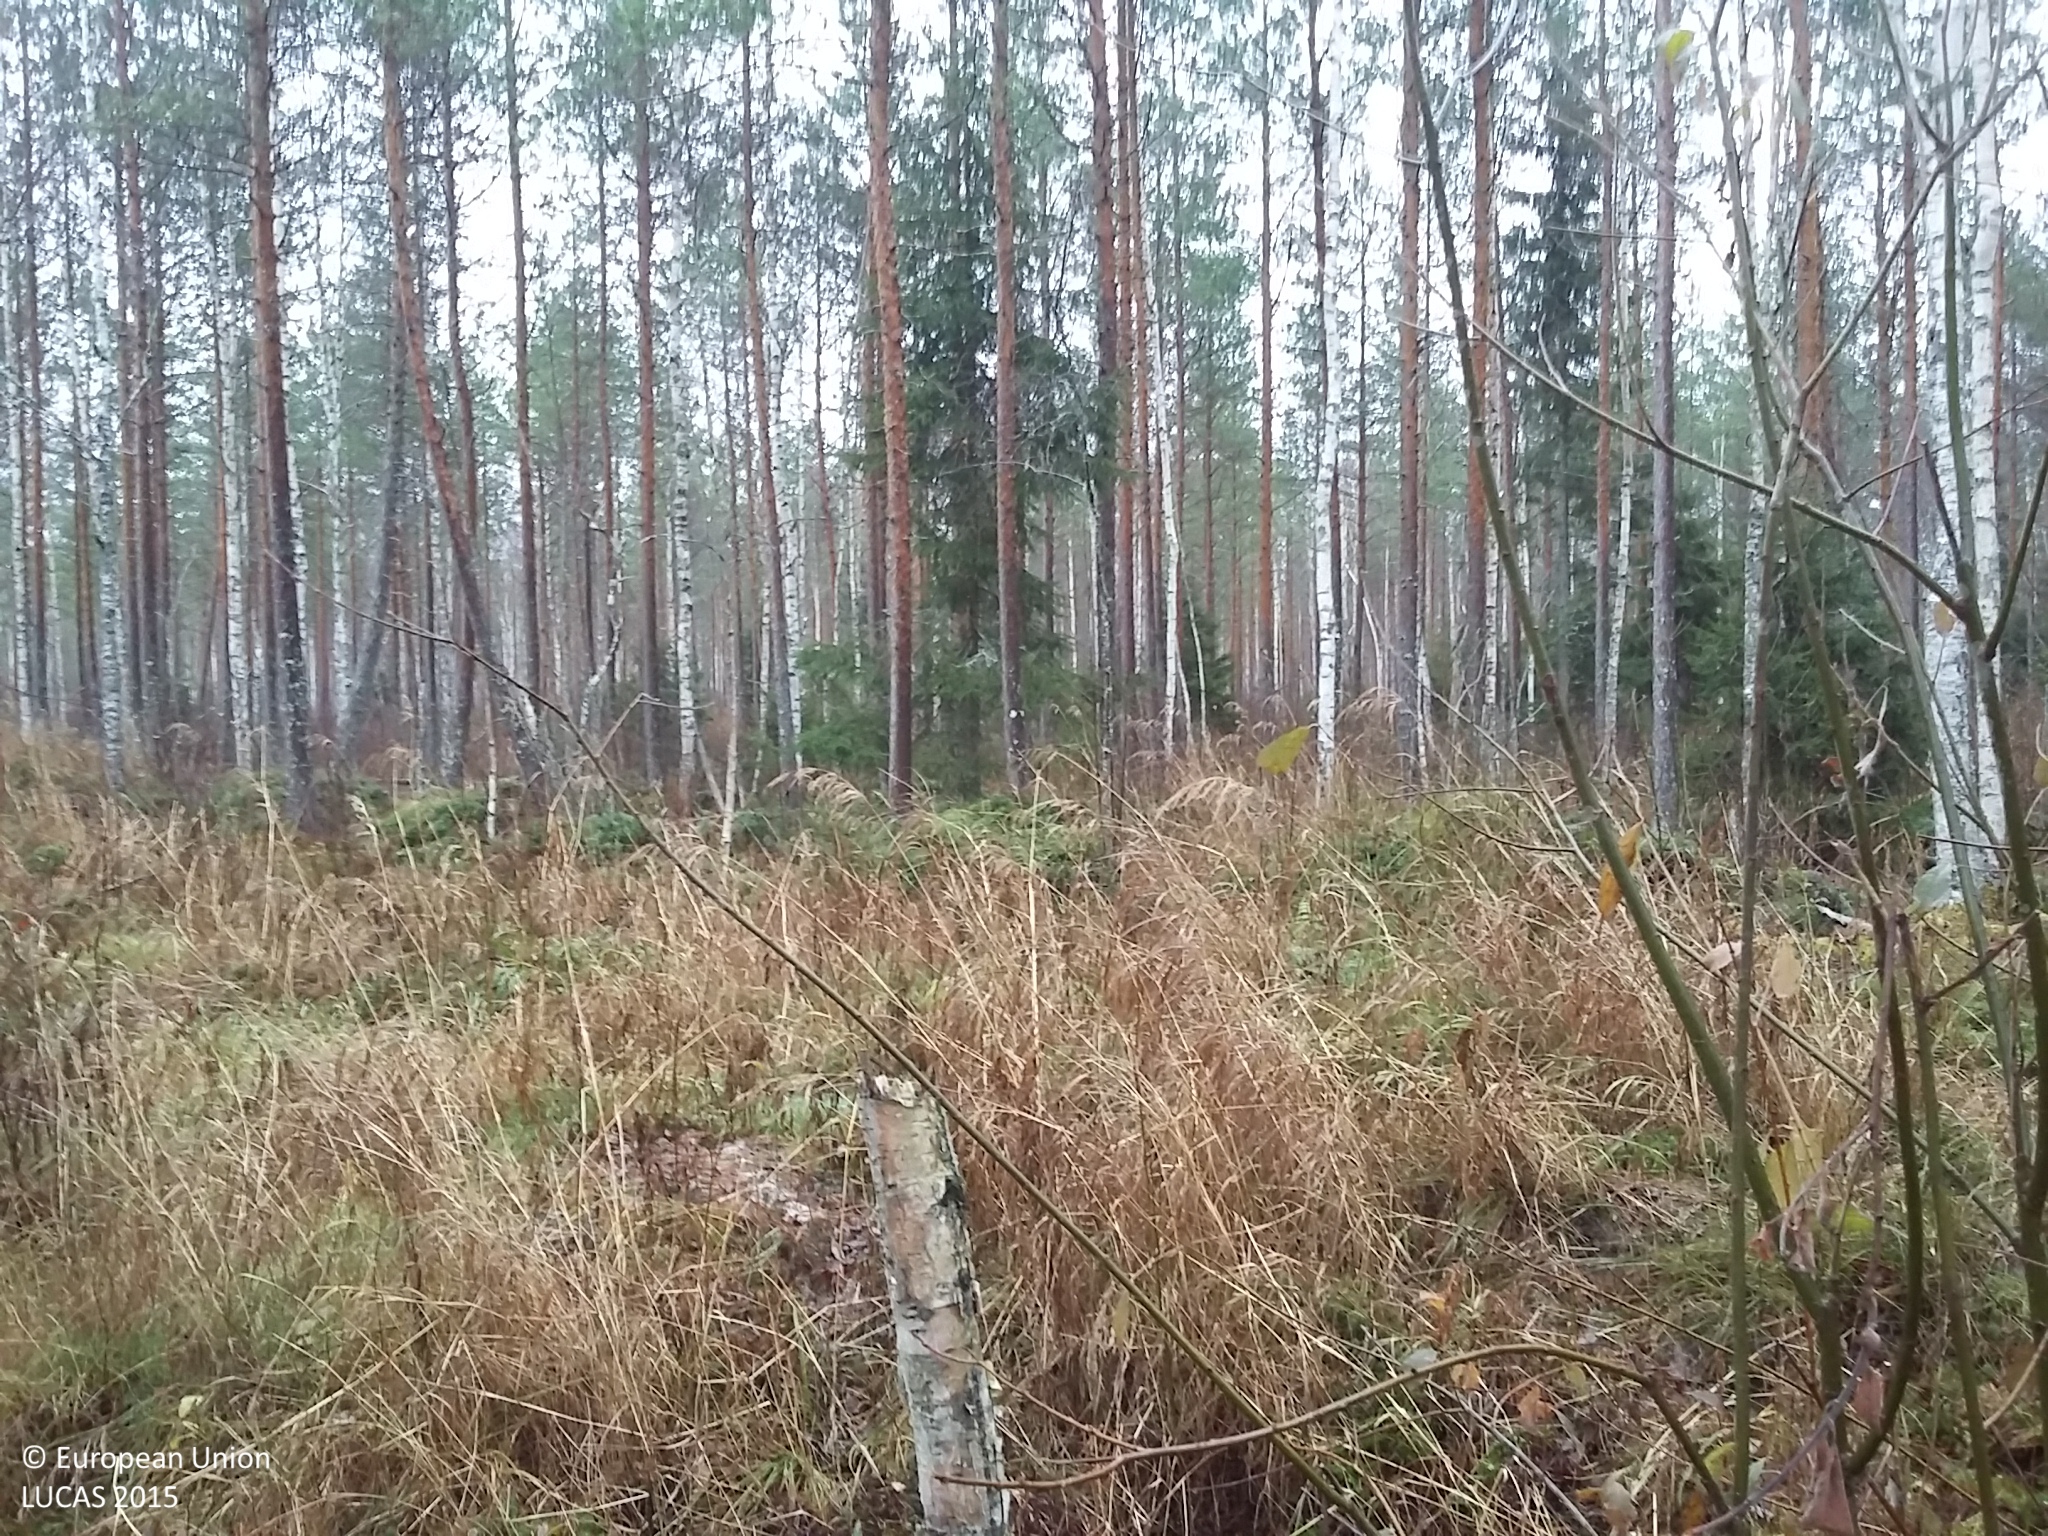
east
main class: Woodland
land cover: Pine dominated coniferous woodland
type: boreal forest
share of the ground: > 75 %
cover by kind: coniferous forest trees 65 %, broadleaved forest trees 10 %, shrubs 10 %, herbaceous plants 10 %, lichens and mosses 5 %
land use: Forestry
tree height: > 5 m
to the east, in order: Pine dominated coniferous woodland; Lichens and moss; Ditches and canals; Pine dominated mixed woodland; Ditches and canals; Other mixed woodland; Pine dominated mixed woodland; Ditches and canals; Other mixed woodland; Ditches and canals; Lichens and moss; Pine dominated mixed woodland; Ditches and canals; Other mixed woodland; Tracks; Broadleaved woodland; Ditches and canals; Pine dominated mixed woodland
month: October
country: FI
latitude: 64.5266
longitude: 25.4039
